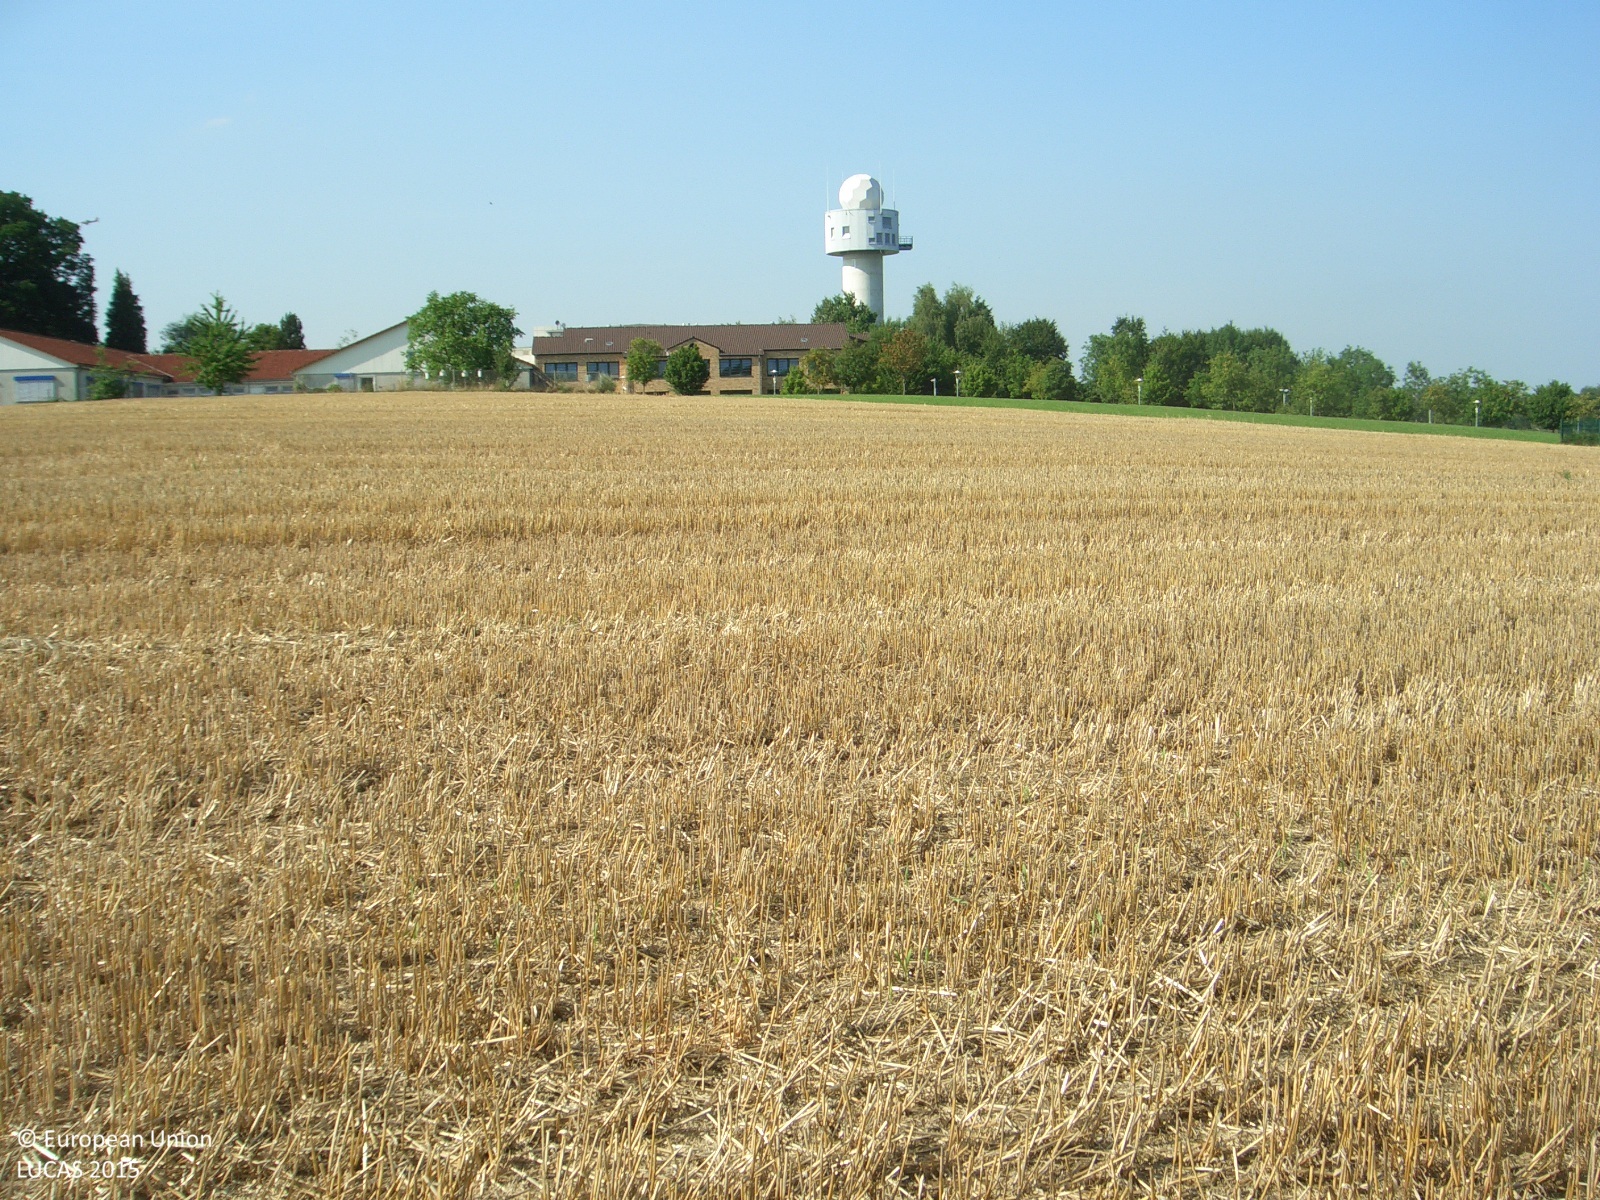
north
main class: Cropland
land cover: Barley
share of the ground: 25 - 50 %
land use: Agriculture (excluding fallow land and kitchen gardens)
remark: Harvested field
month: July
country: DE
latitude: 51.4034
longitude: 6.9668
